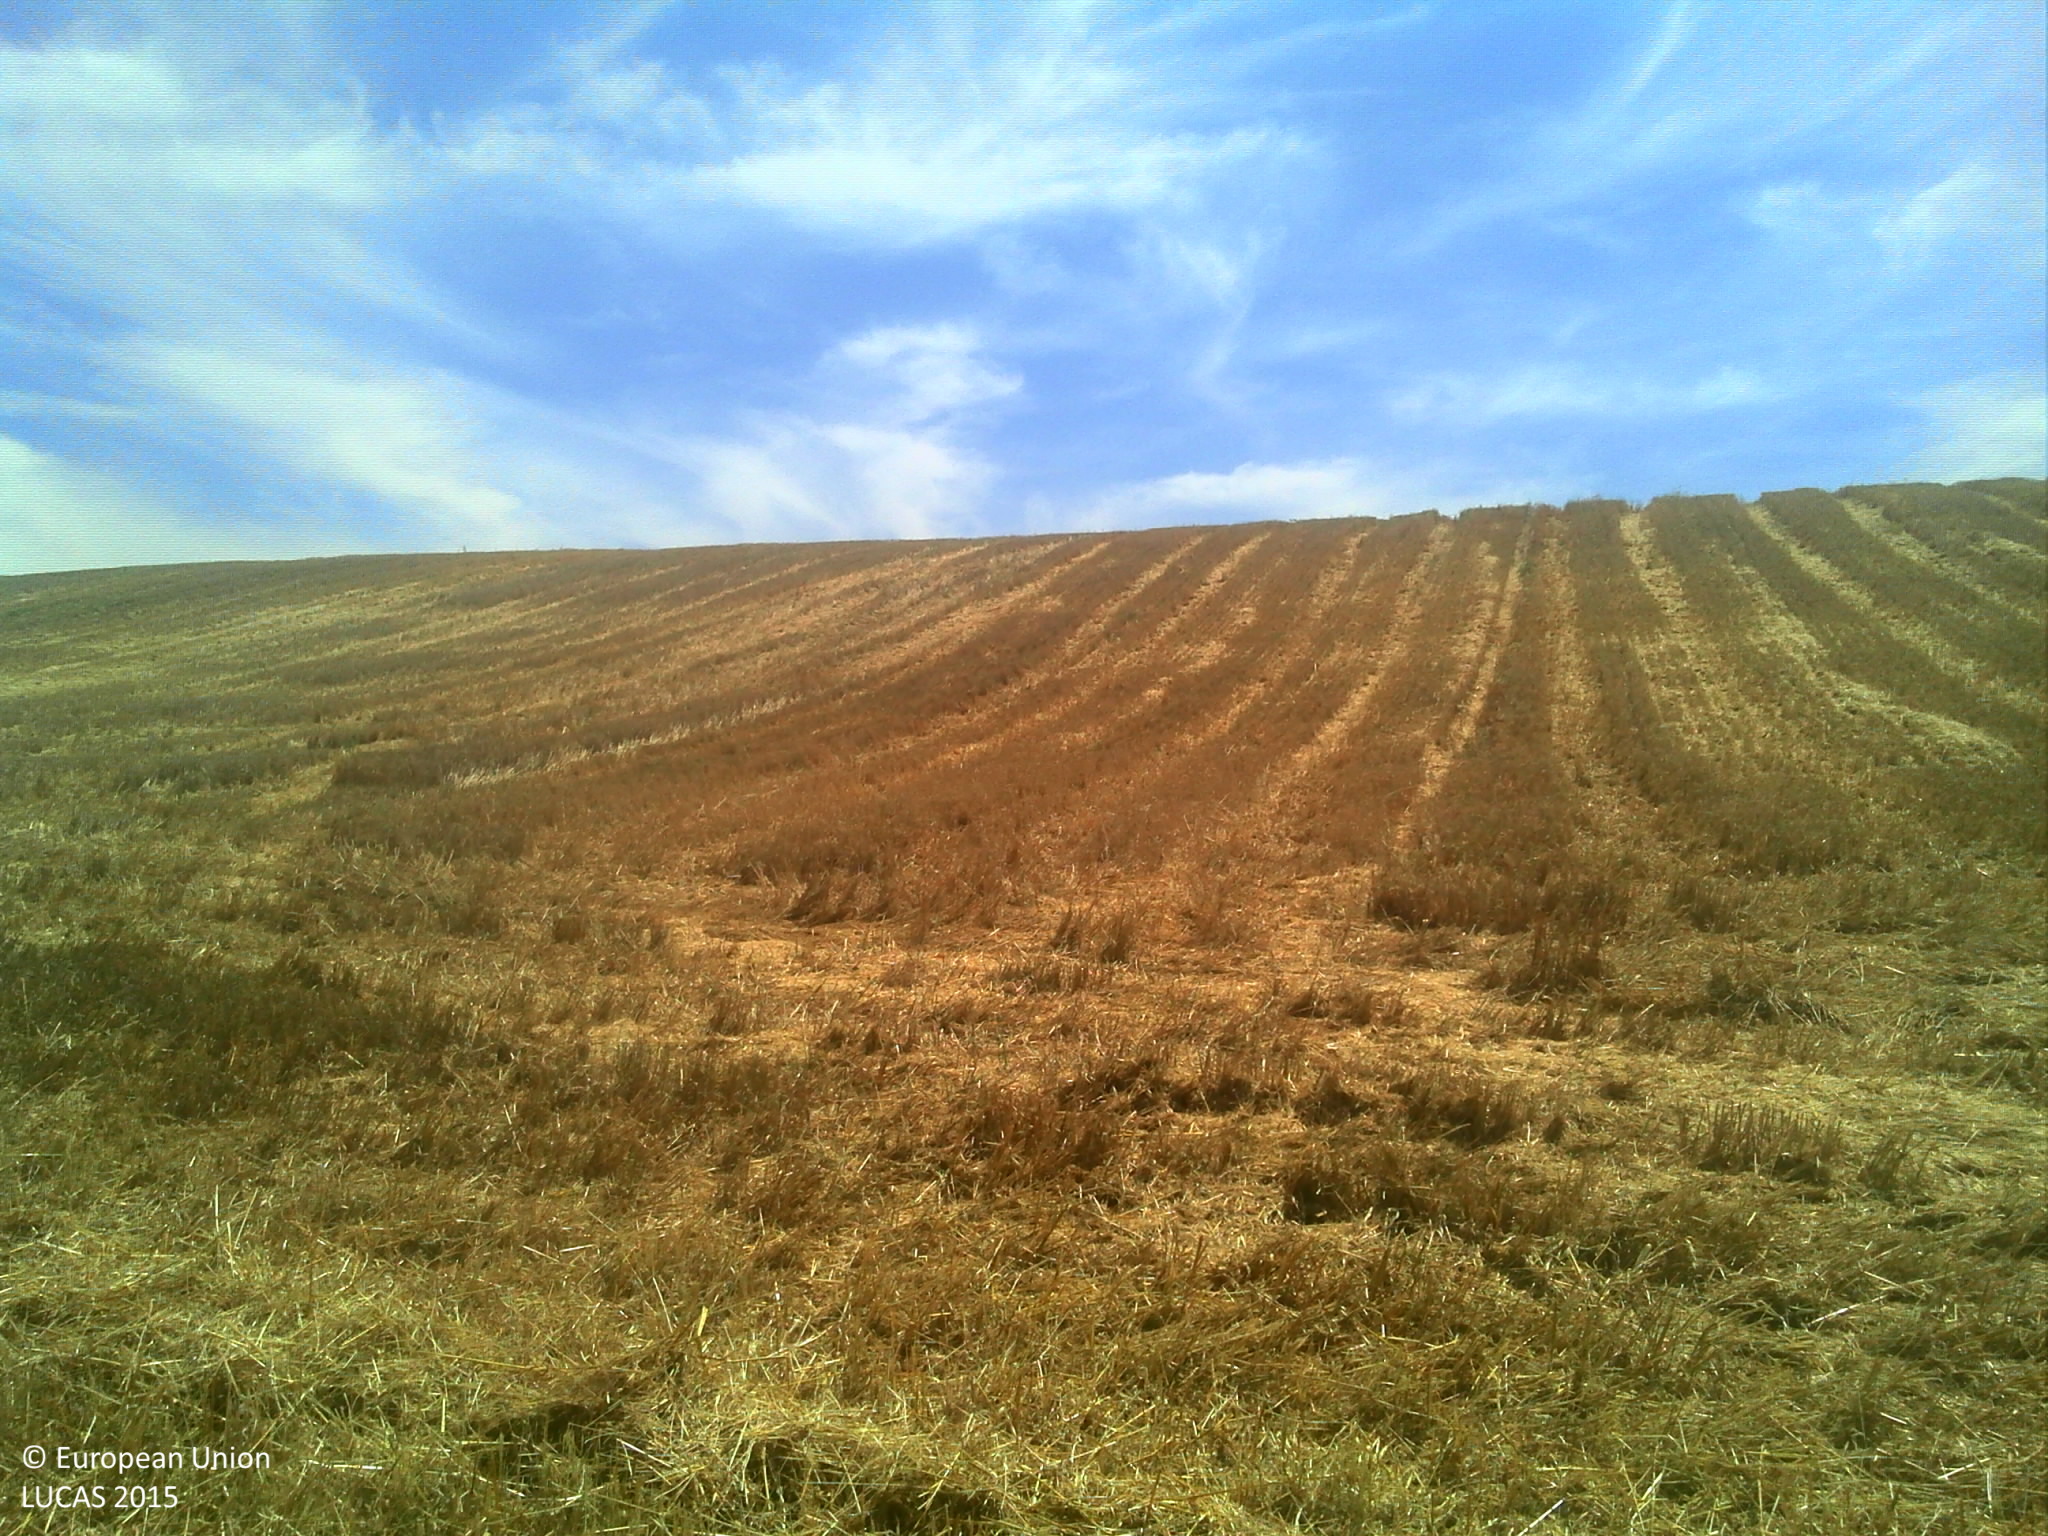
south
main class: Cropland
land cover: Common wheat
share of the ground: > 75 %
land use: Agriculture (excluding fallow land and kitchen gardens)
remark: Harvested field
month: July
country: FR
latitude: 43.4523
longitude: 1.4395
